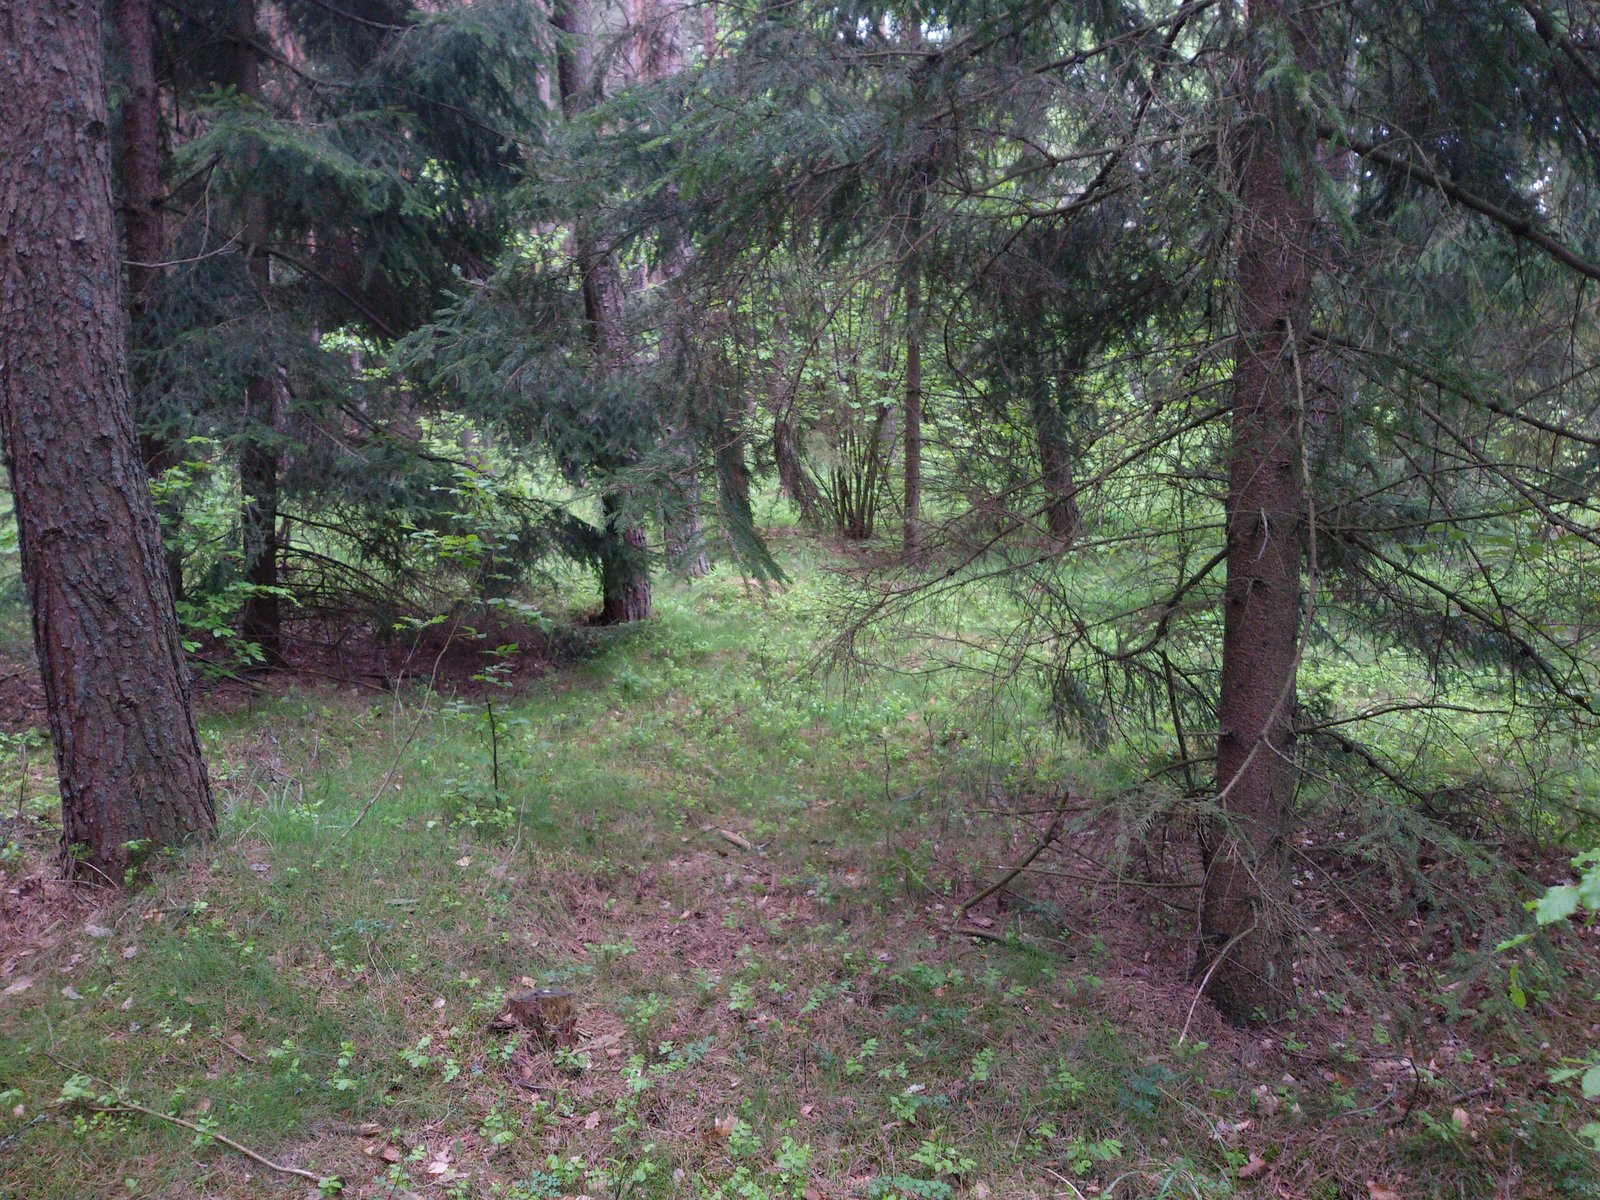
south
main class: Woodland
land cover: Pine dominated coniferous woodland
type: hemiboreal forest and nemoral coniferous forest and mixed broadleaved-coniferous forest
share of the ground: > 75 %
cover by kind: coniferous forest trees 80 %, shrubs 10 %, herbaceous plants 10 %
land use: Forestry
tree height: > 5 m
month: May
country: PL
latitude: 53.5661
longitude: 21.0511
